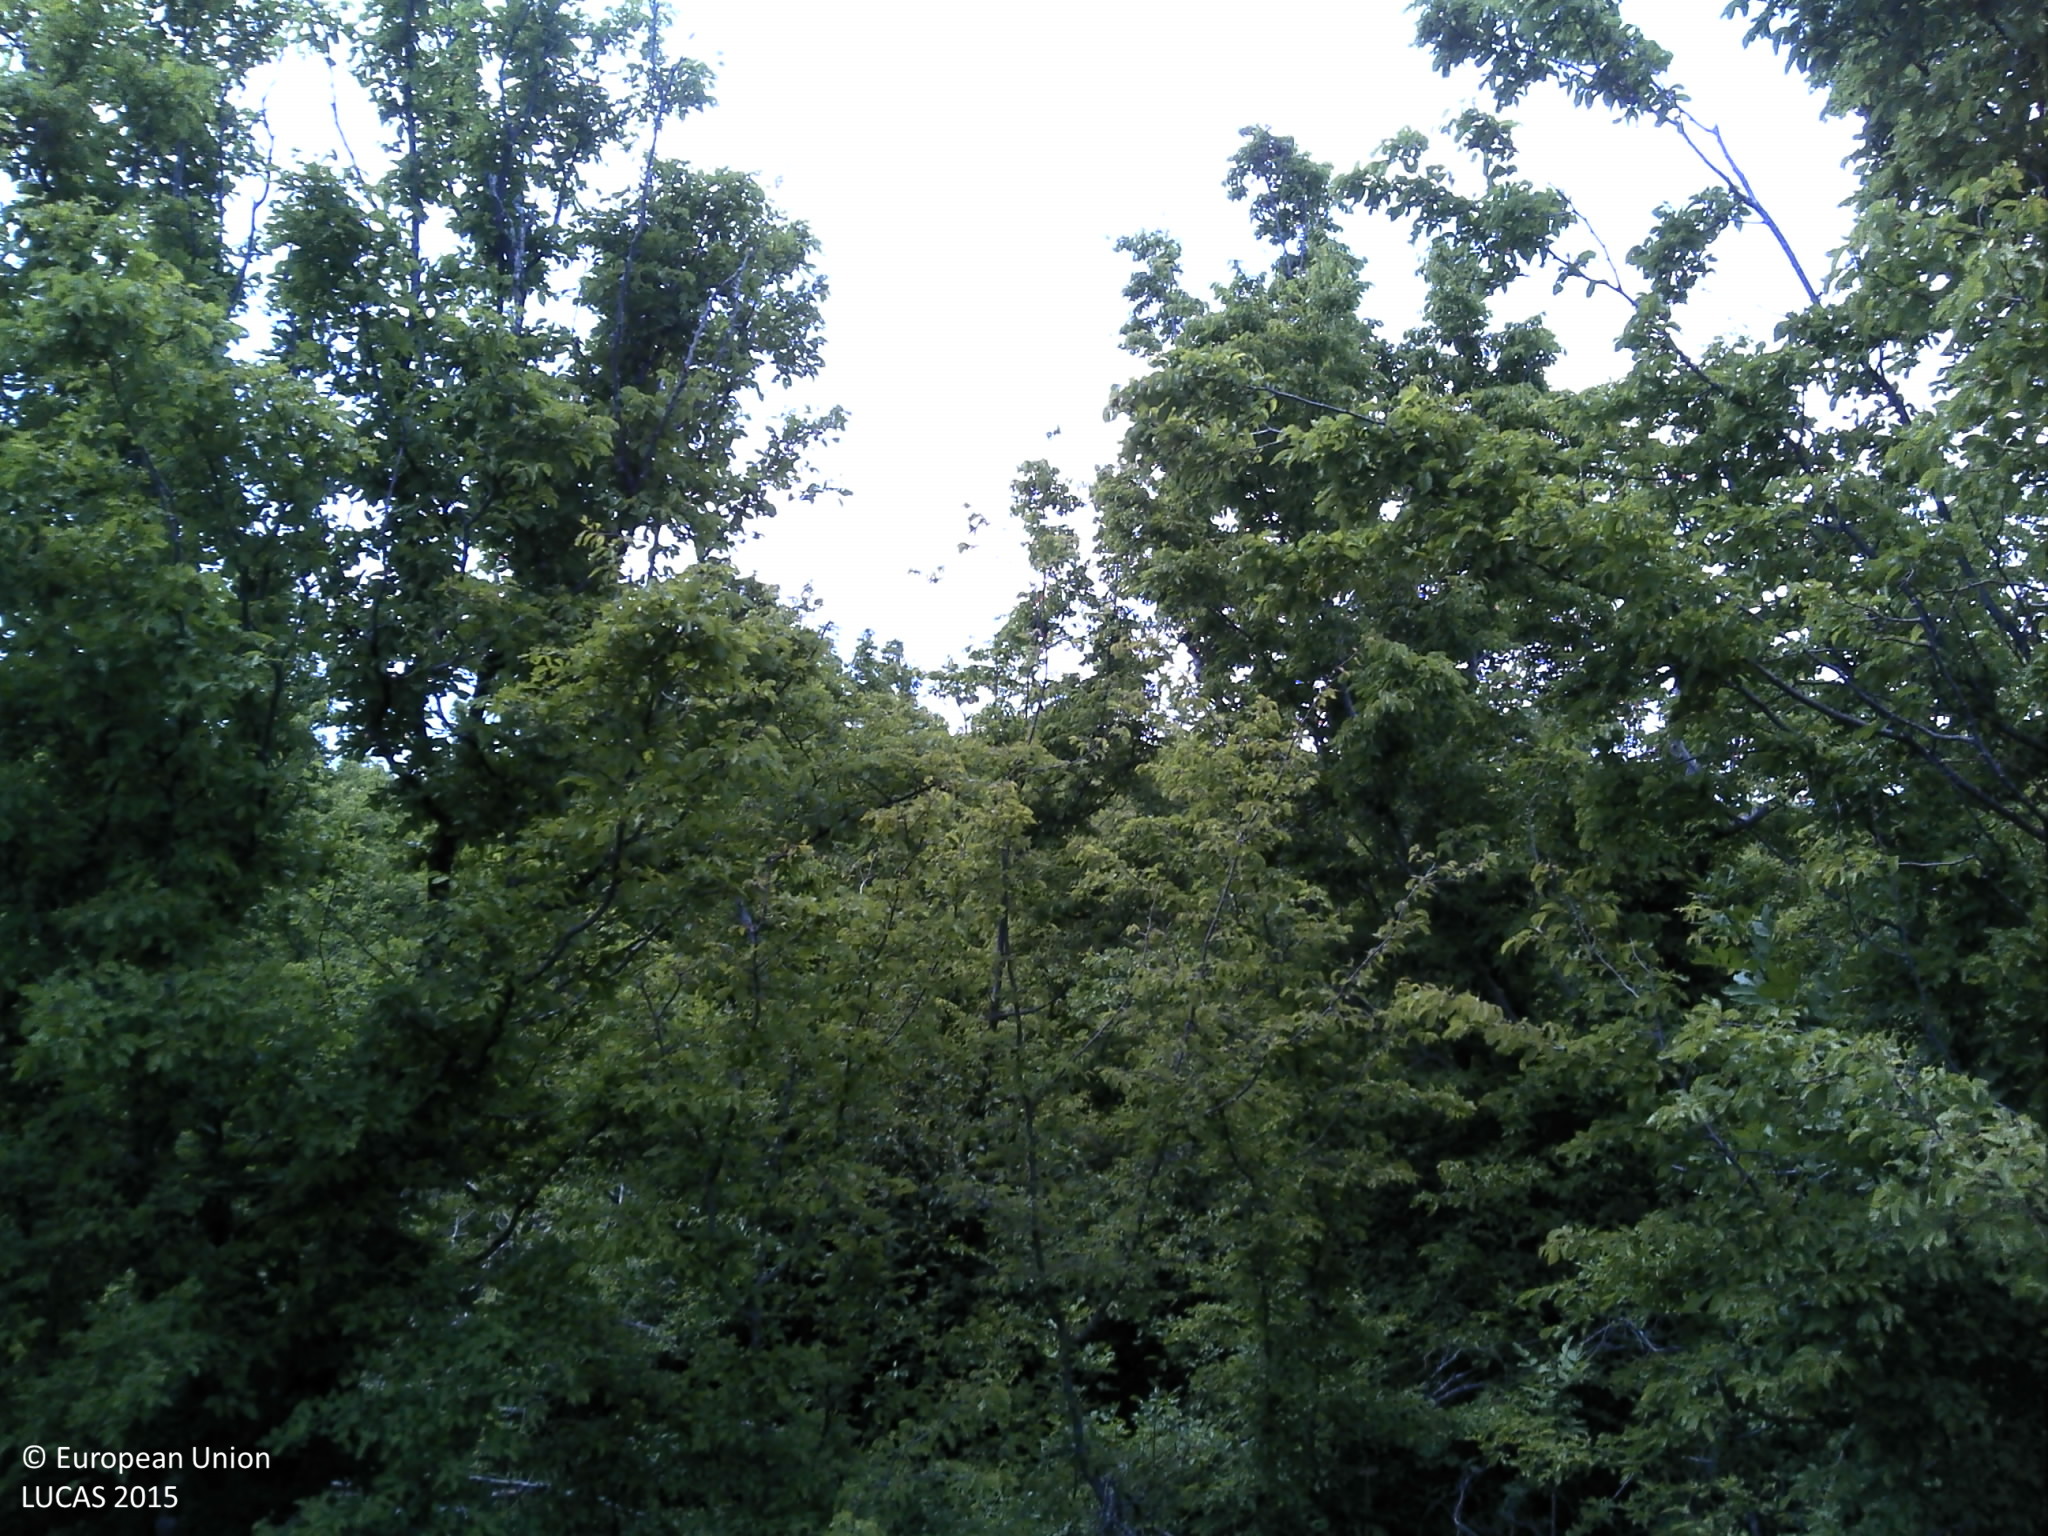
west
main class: Woodland
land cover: Broadleaved woodland
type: thermophilous deciduous forest
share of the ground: 25 - 50 %
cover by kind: shrubs 40 %, broadleaved forest trees 35 %, unconsolidated bare surface 15 %, coniferous forest trees 10 %
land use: Semi-natural and natural areas not in use
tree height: > 5 m
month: June
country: HR
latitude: 44.0671
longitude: 16.0226
